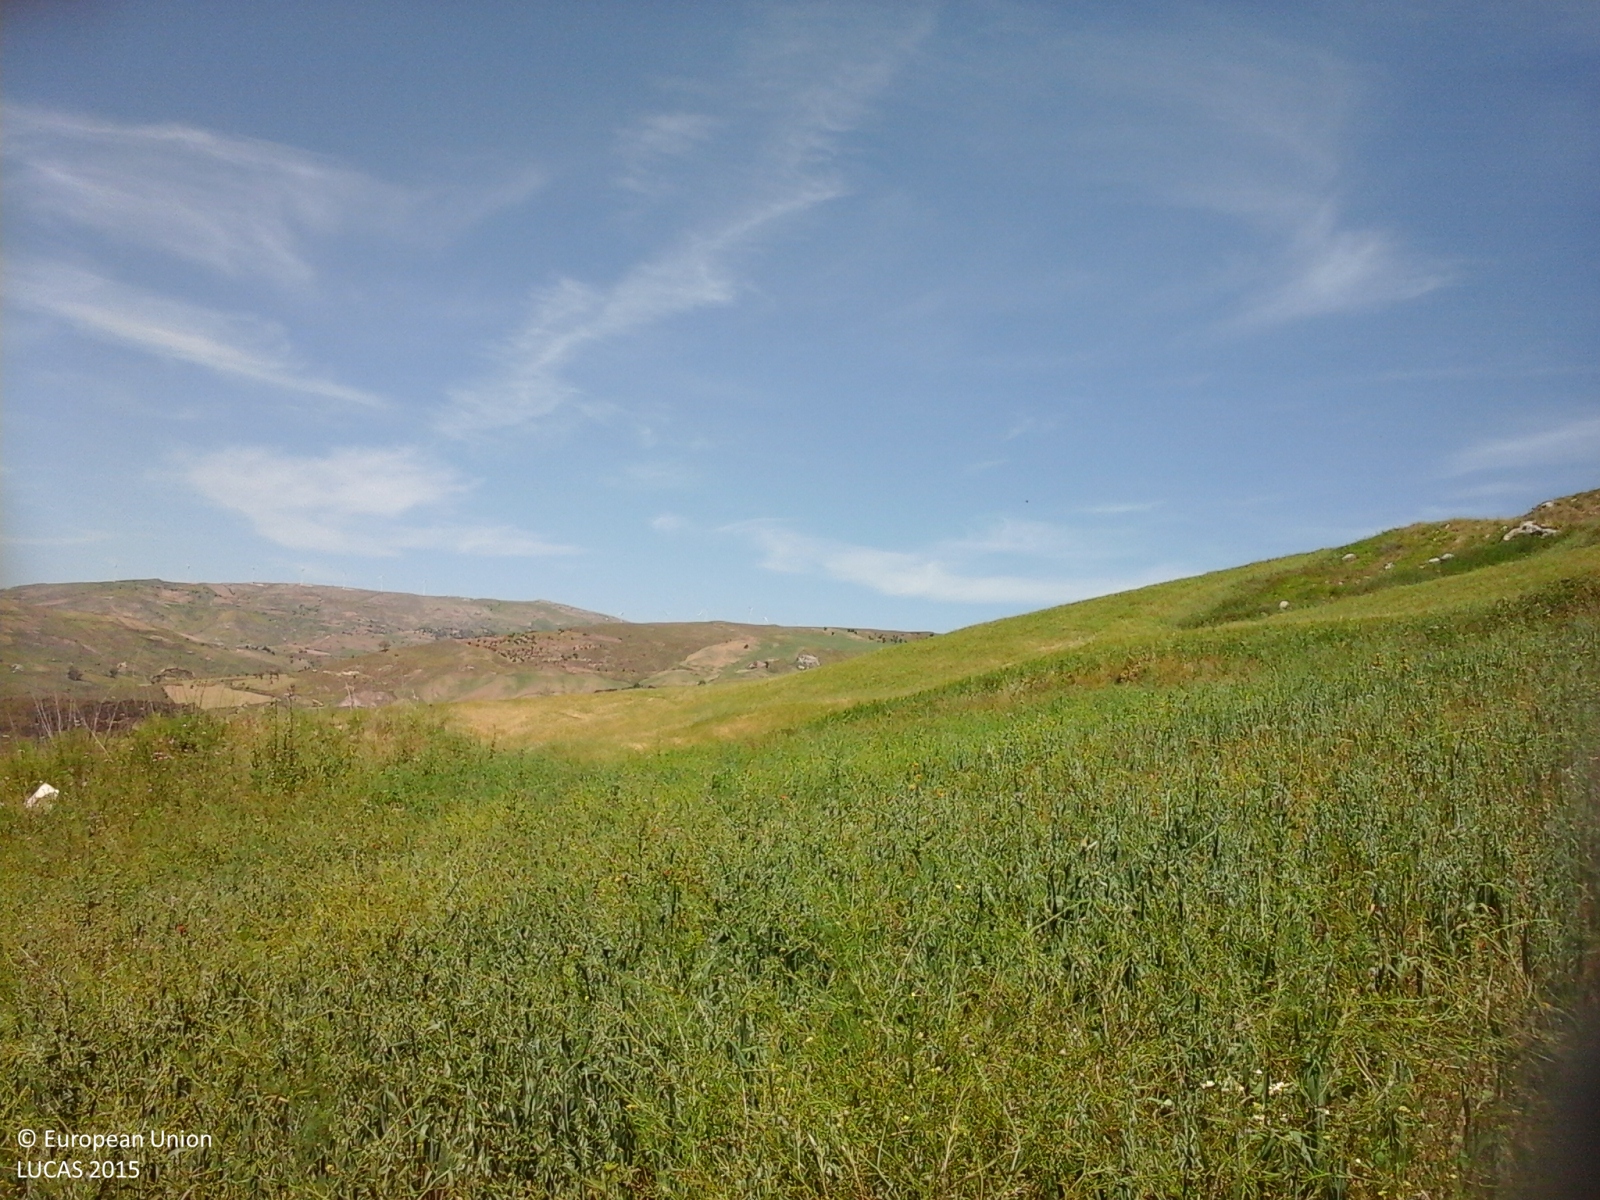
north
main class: Cropland
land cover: Mixed cereals for fodder
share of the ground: > 75 %
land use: Agriculture (excluding fallow land and kitchen gardens)
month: May
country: IT
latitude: 37.5548
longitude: 13.9889
